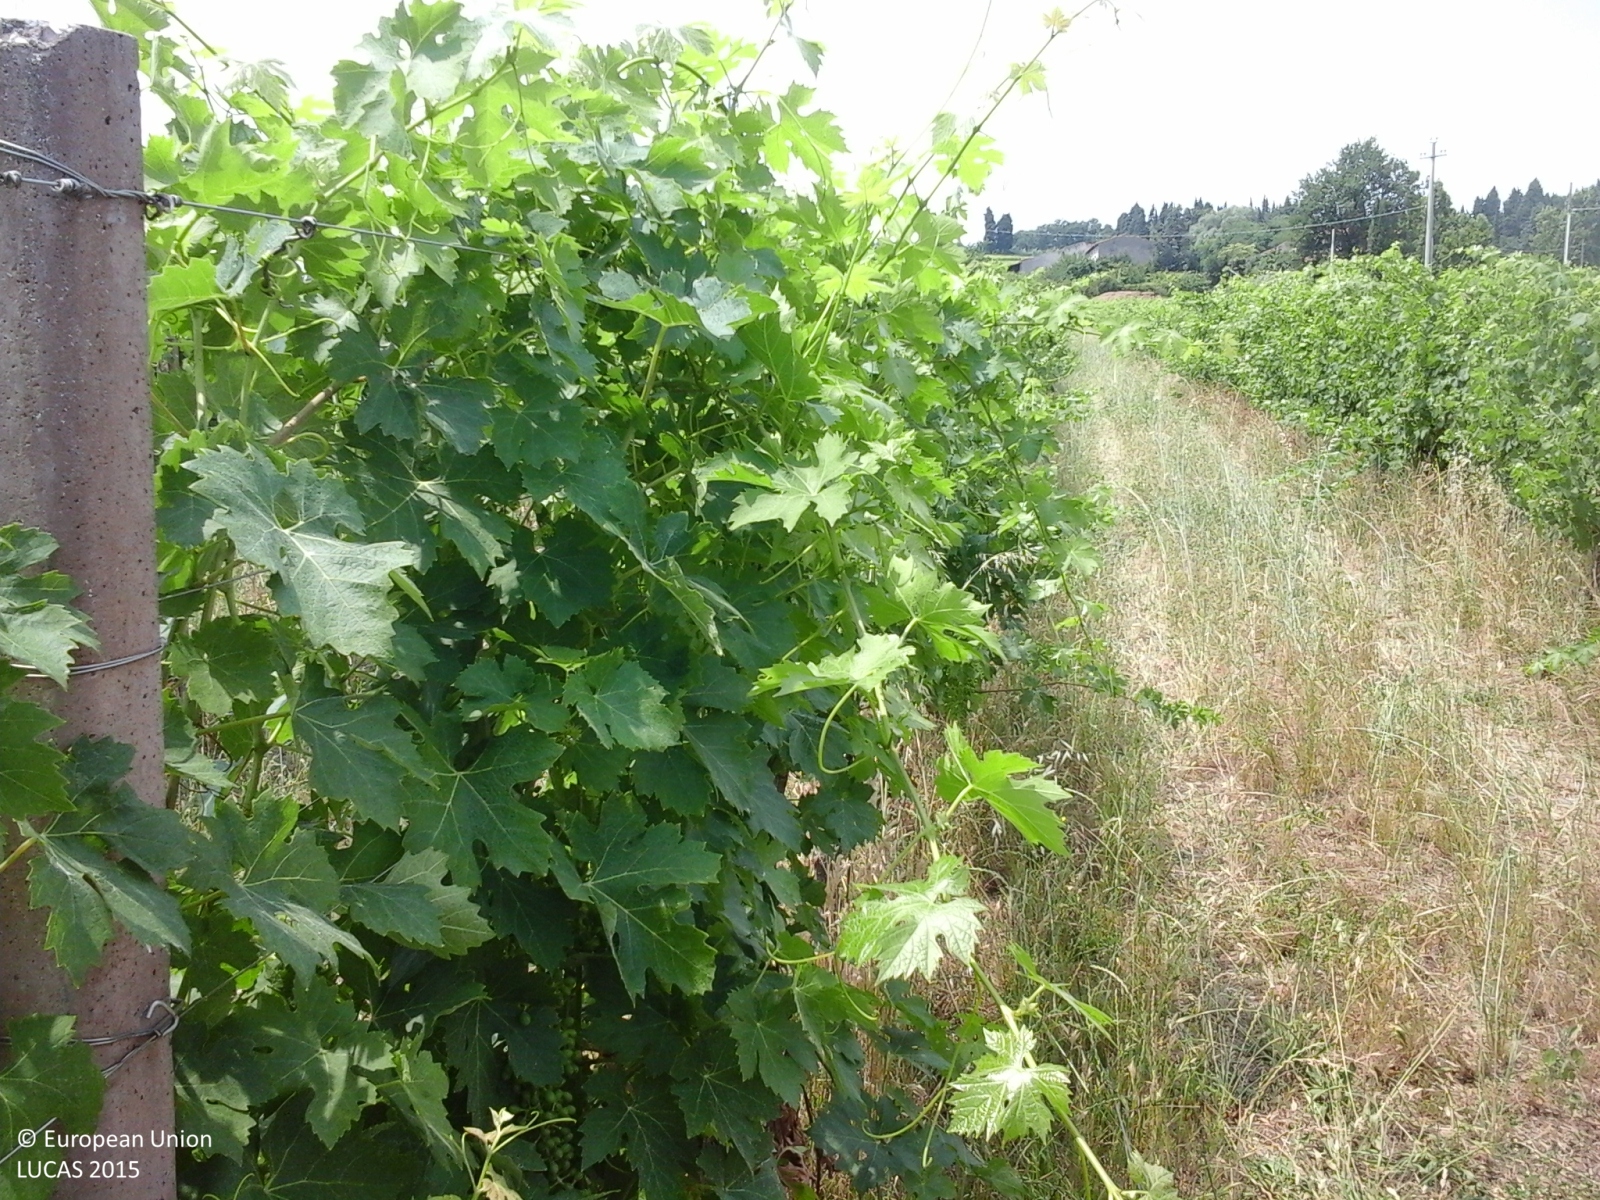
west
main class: Cropland
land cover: Vineyards
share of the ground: 25 - 50 %
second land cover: Grassland without tree/shrub cover
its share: > 75 %
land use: Agriculture (excluding fallow land and kitchen gardens)
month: June
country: IT
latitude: 45.3930
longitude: 10.8288
